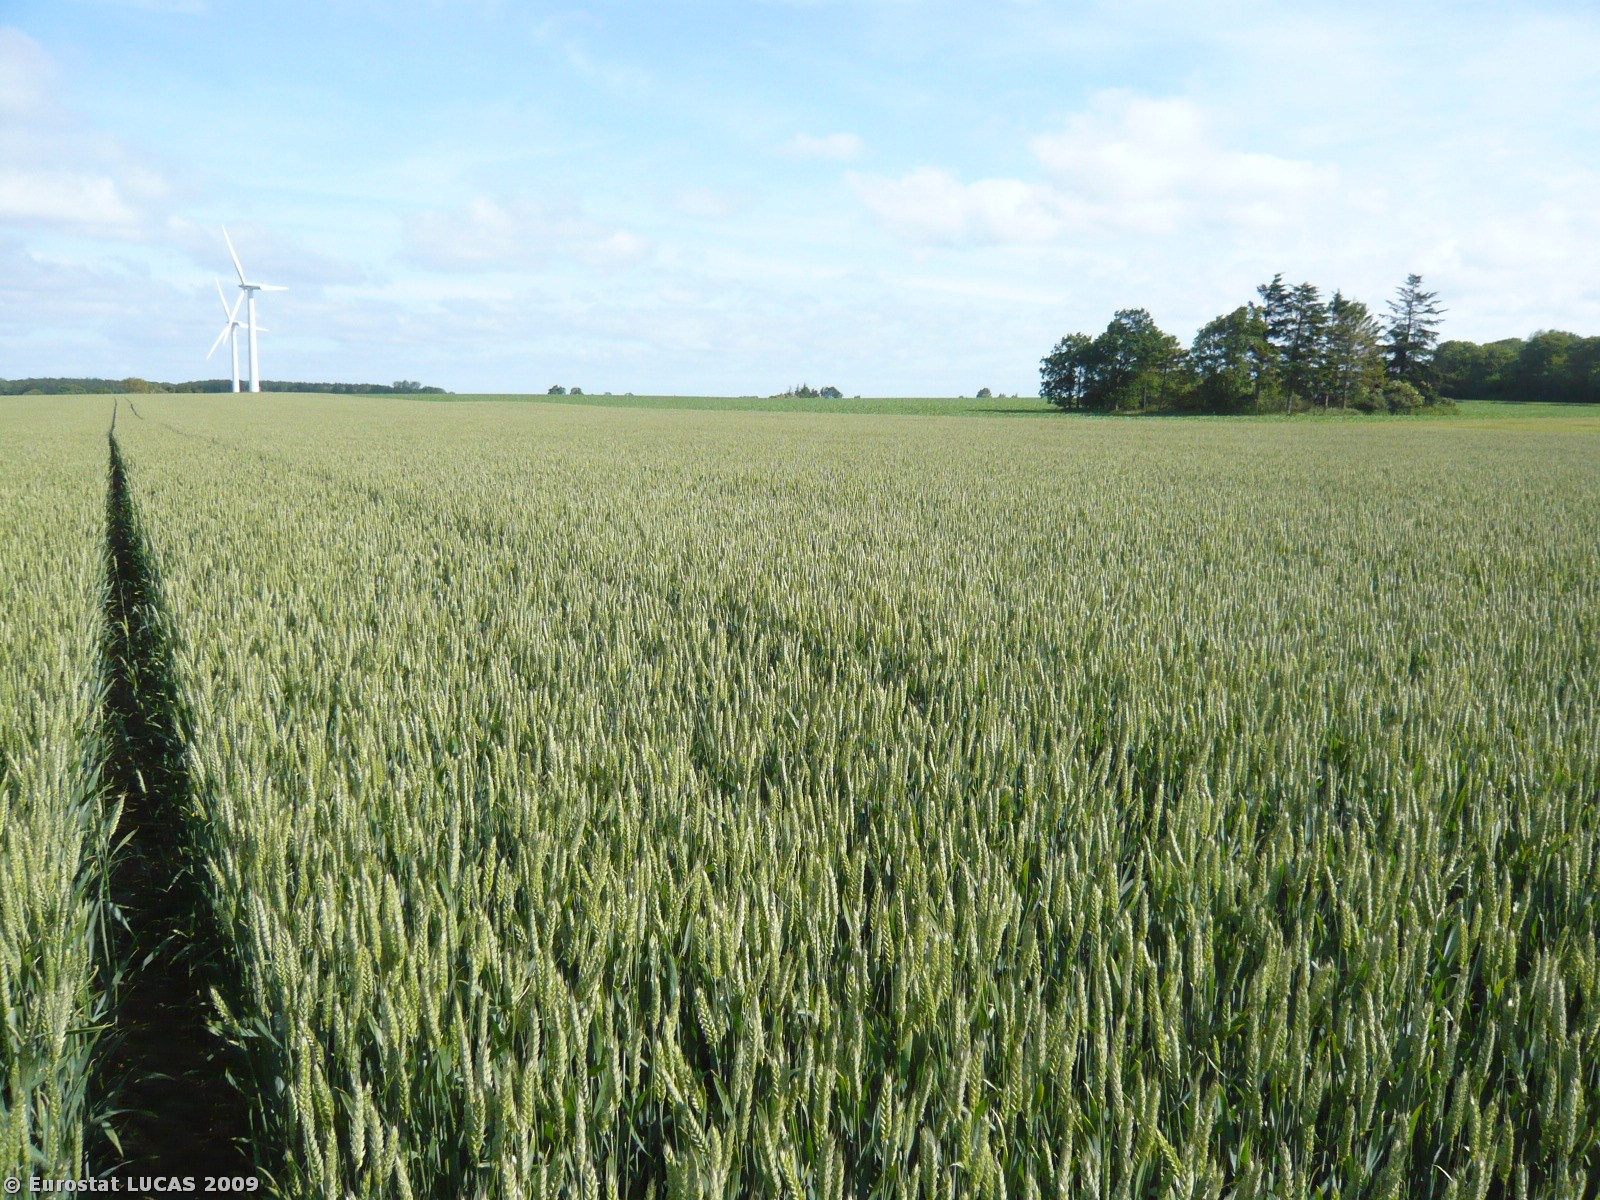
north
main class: Cropland
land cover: Common wheat
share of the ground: > 75 %
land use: Agriculture (excluding fallow land and kitchen gardens)
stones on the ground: < 10 %
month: June
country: DK
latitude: 54.9244
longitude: 11.1382
